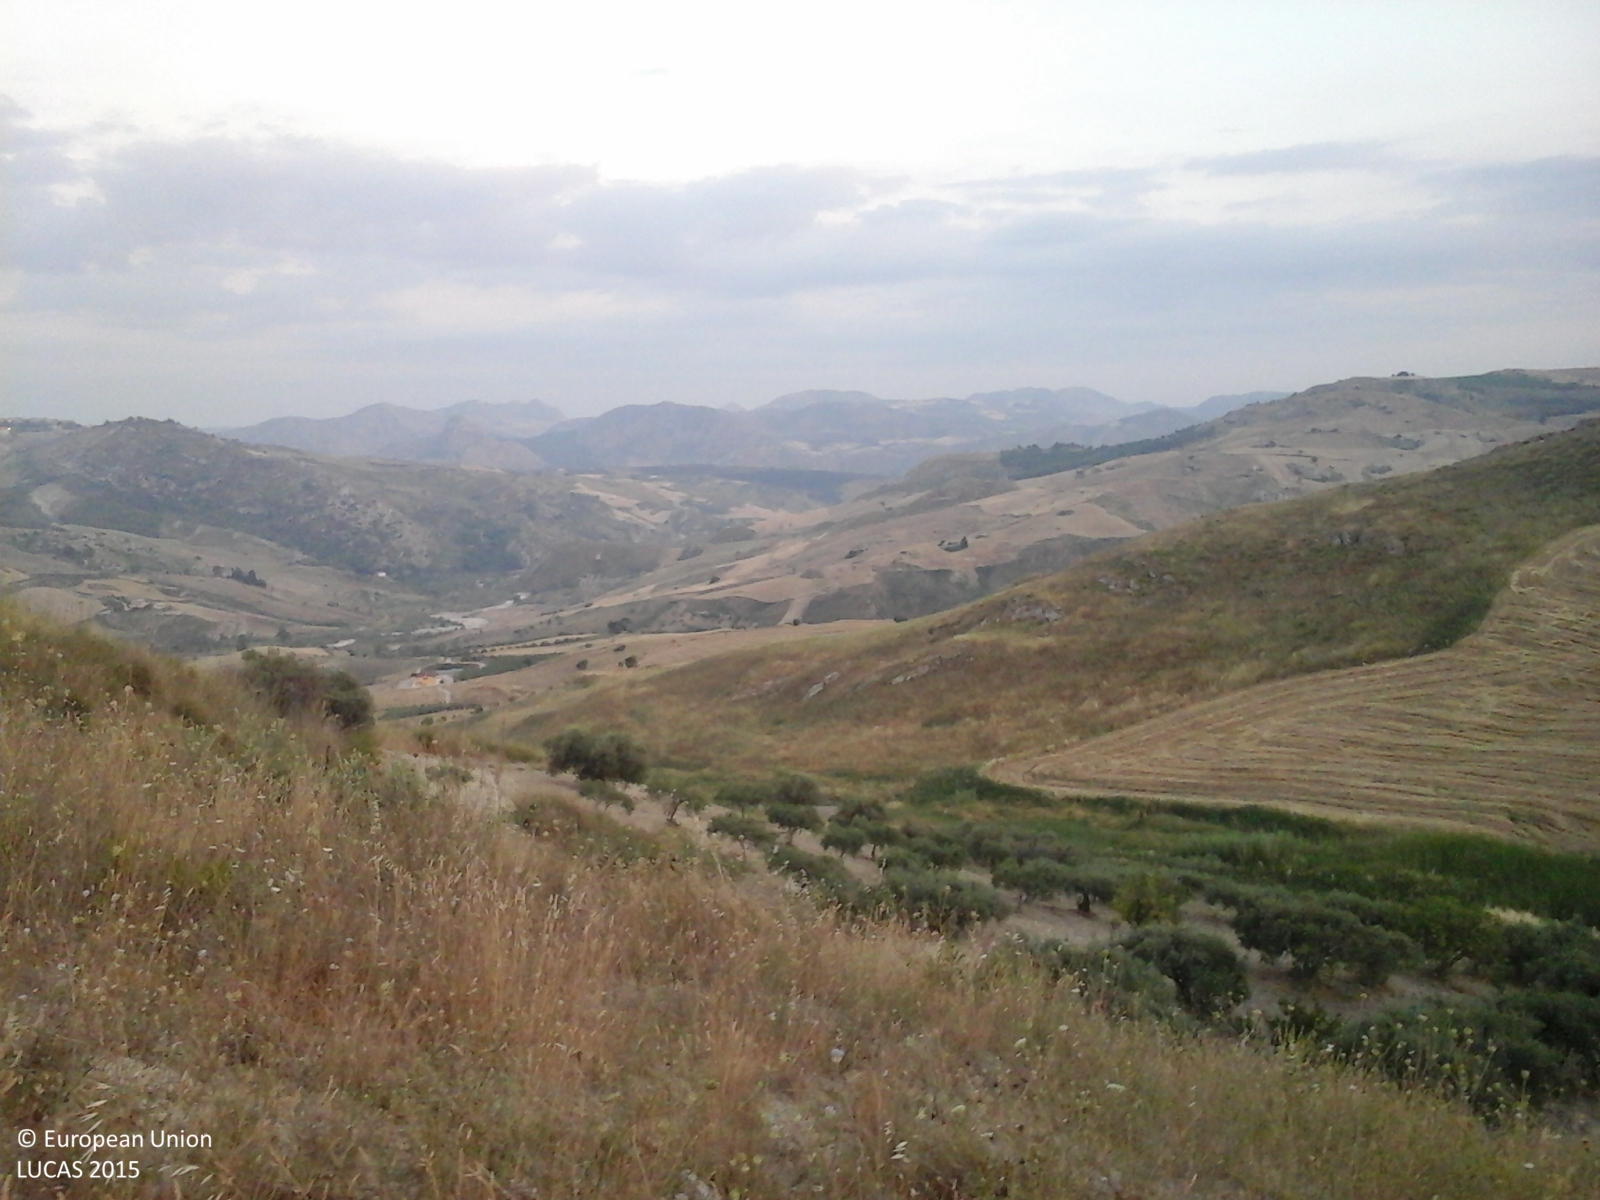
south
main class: Cropland
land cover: Durum wheat
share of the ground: > 75 %
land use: Agriculture (excluding fallow land and kitchen gardens)
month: July
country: IT
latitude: 37.5380
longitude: 13.4932
